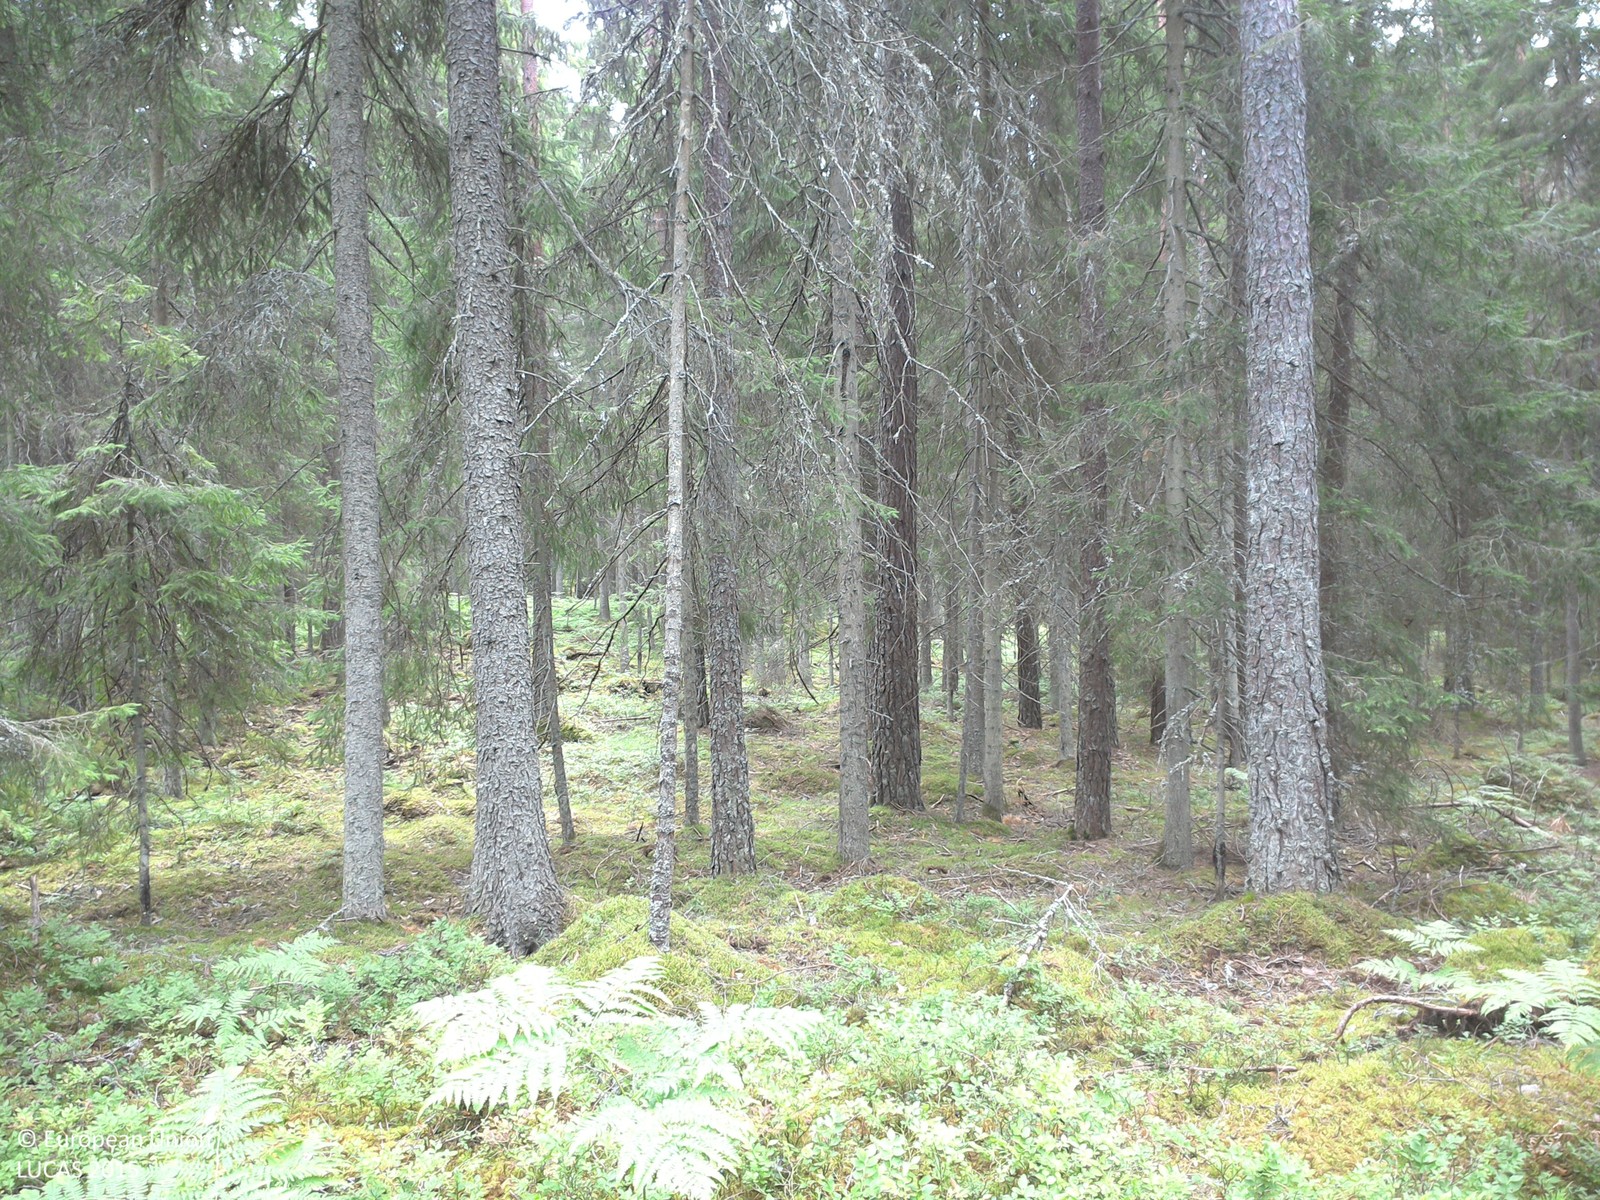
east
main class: Woodland
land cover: Pine dominated coniferous woodland
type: boreal forest
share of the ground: 50 - 75 %
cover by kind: coniferous forest trees 50 %, shrubs 30 %, herbaceous plants 10 %, lichens and mosses 10 %
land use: Forestry
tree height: > 5 m
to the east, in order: Pine dominated coniferous woodland; Spruce dominated coniferous woodland; Paved roads, cycling and walking lanes; Pine dominated mixed woodland; Broadleaved woodland; Spruce dominated coniferous woodland; Broadleaved woodland; Spruce dominated mixed woodland
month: July
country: SE
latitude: 57.7594
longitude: 16.0308
